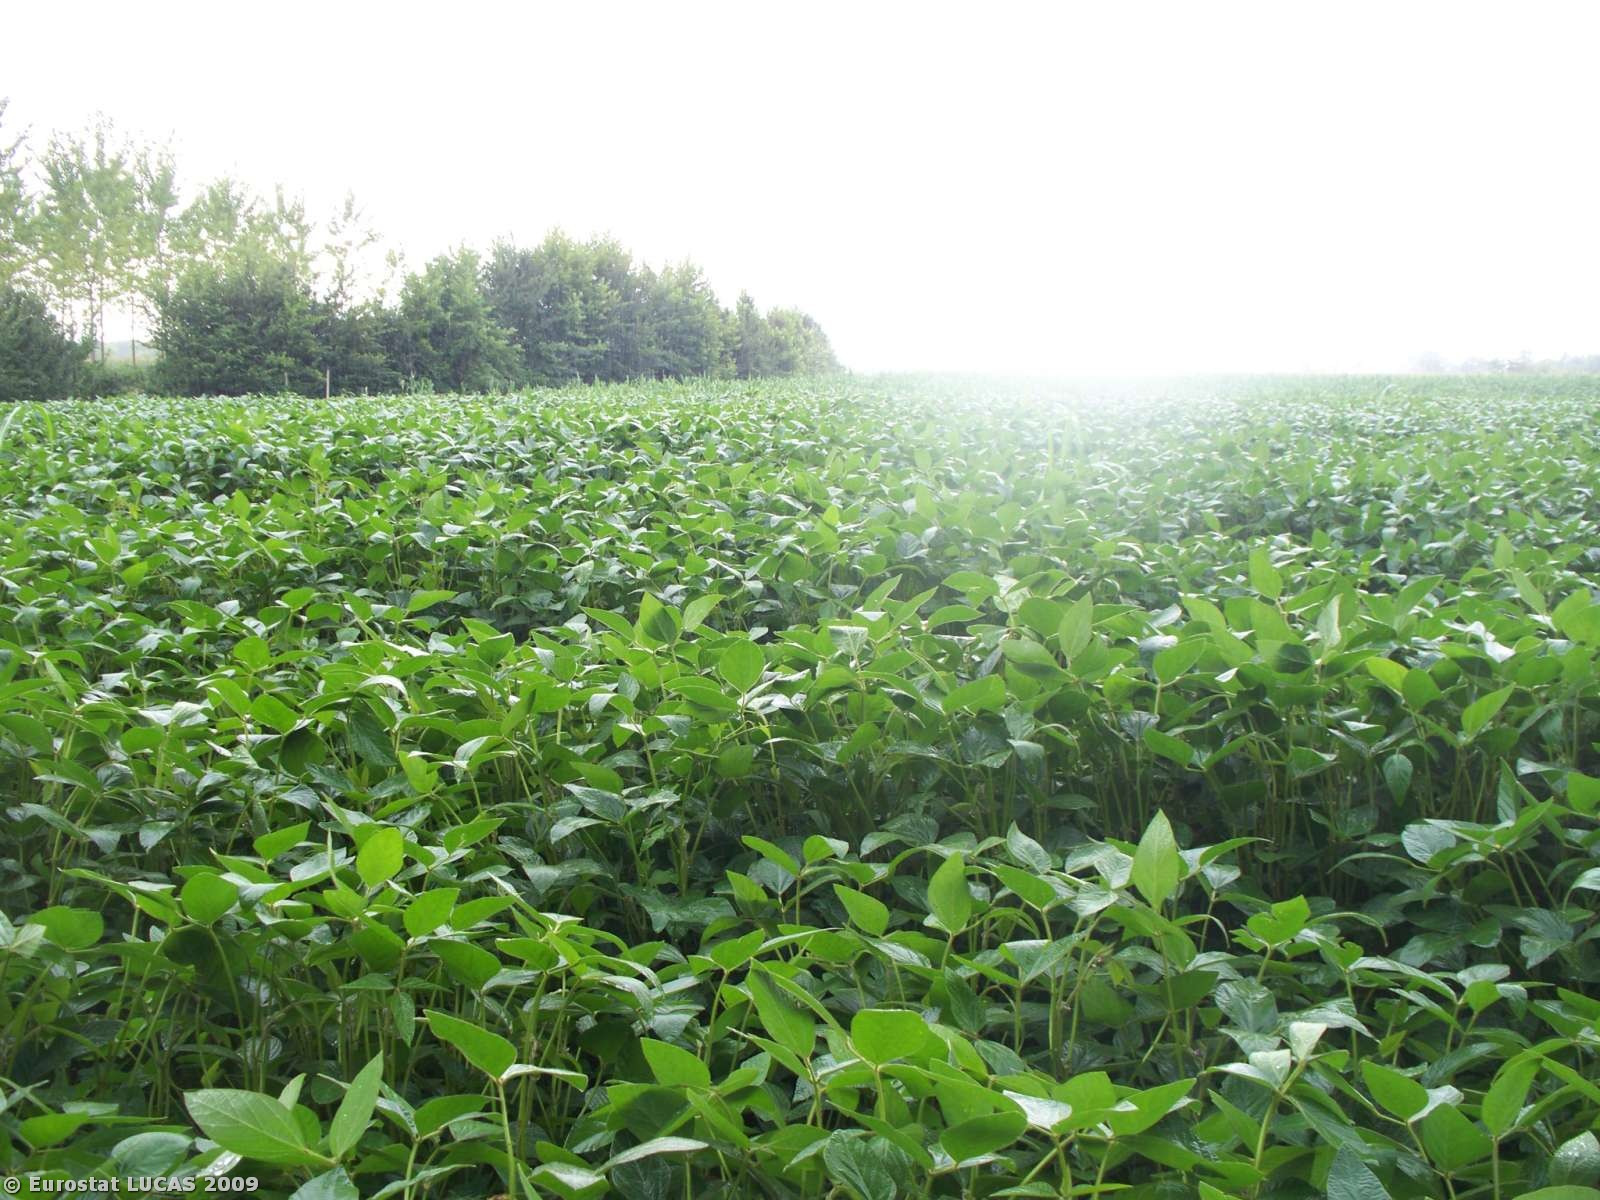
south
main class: Cropland
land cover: Soya
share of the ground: > 75 %
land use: Agriculture (excluding fallow land and kitchen gardens)
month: July
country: IT
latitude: 45.8712
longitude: 12.5087
